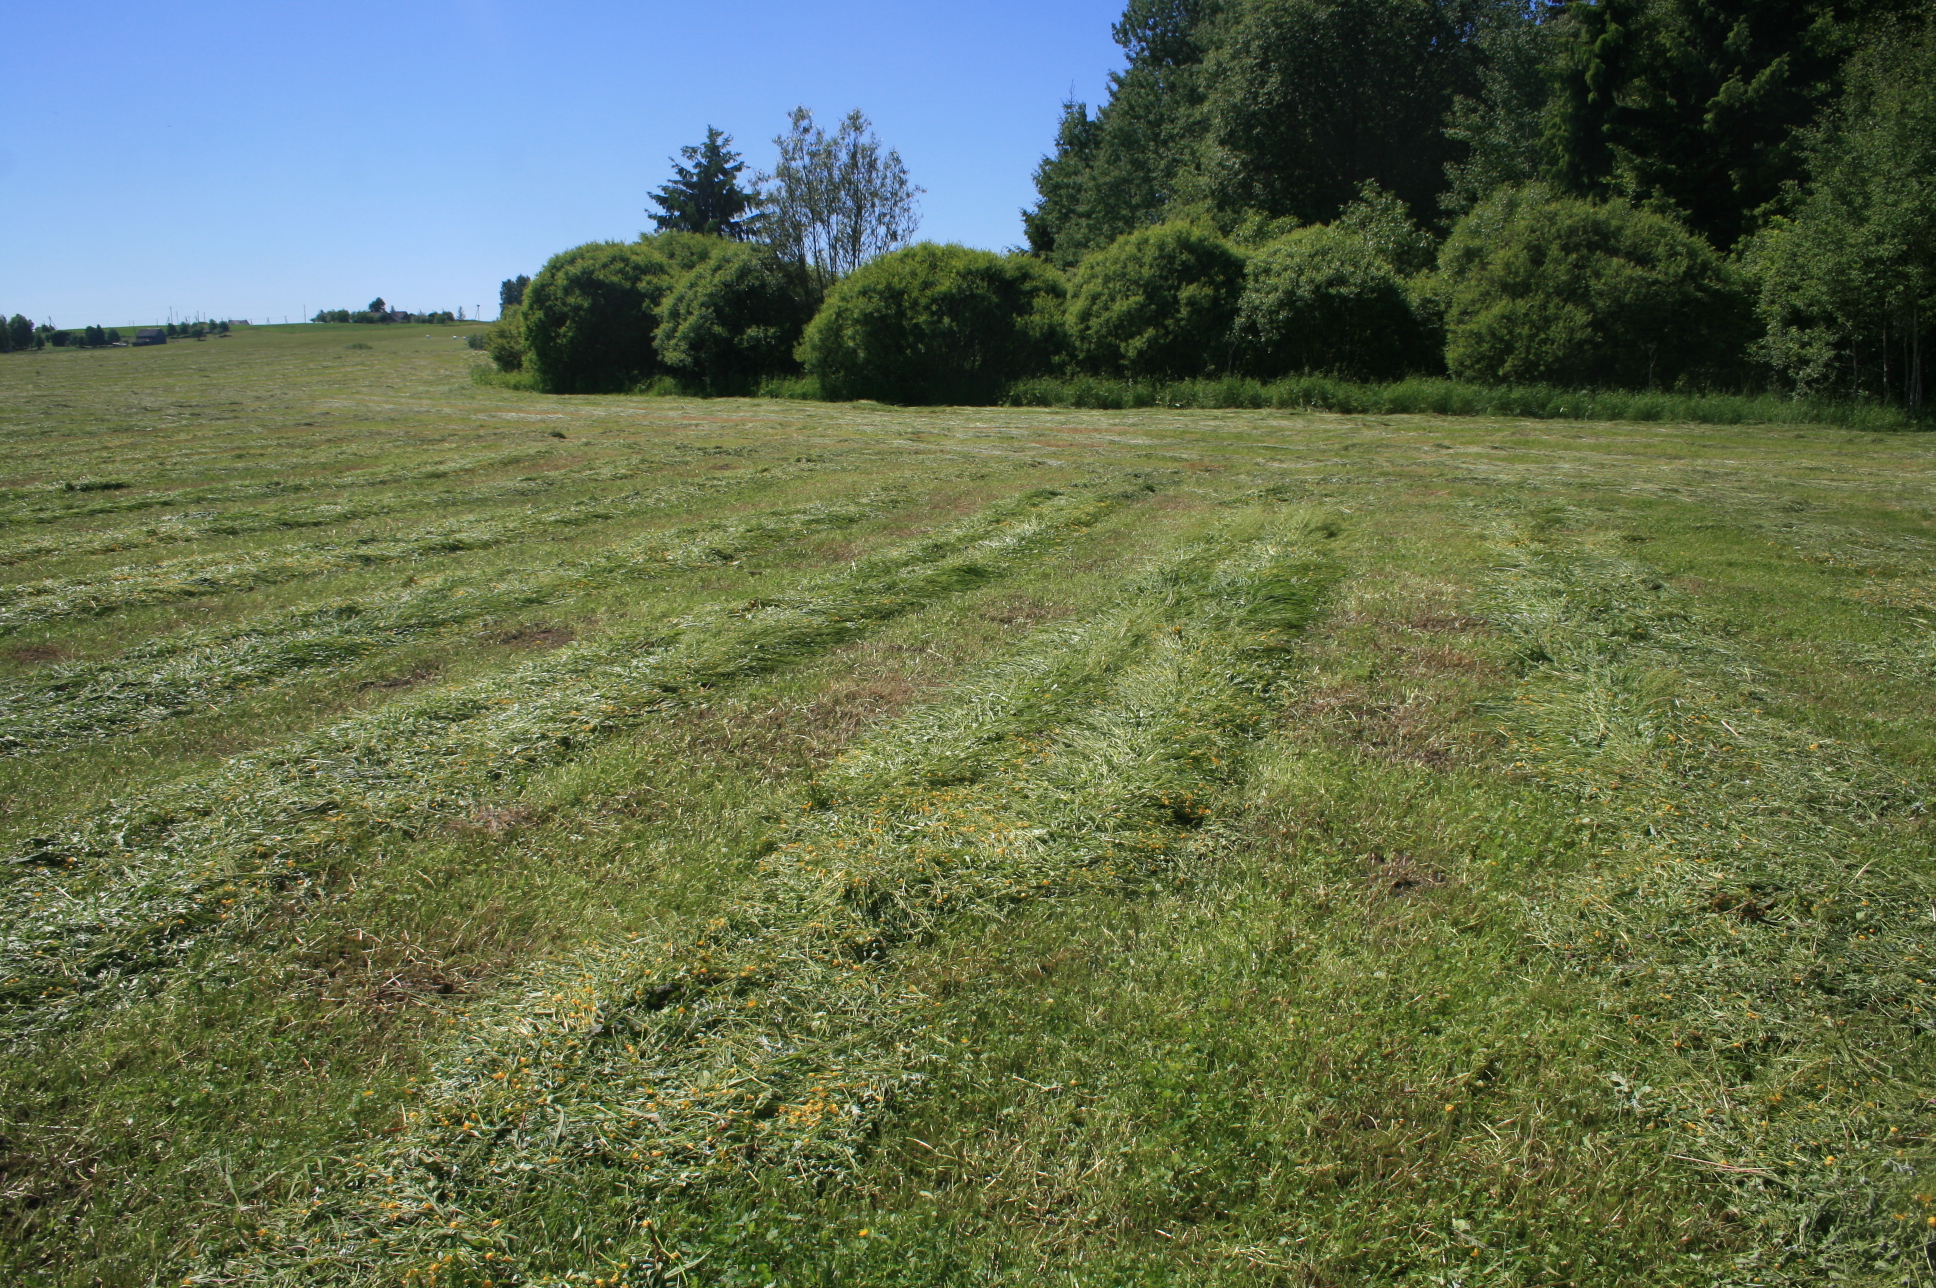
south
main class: Grassland
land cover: Grassland without tree/shrub cover
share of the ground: > 75 %
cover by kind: herbaceous plants 100 %
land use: Agriculture (excluding fallow land and kitchen gardens)
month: June
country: LT
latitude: 55.5769
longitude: 22.0932
